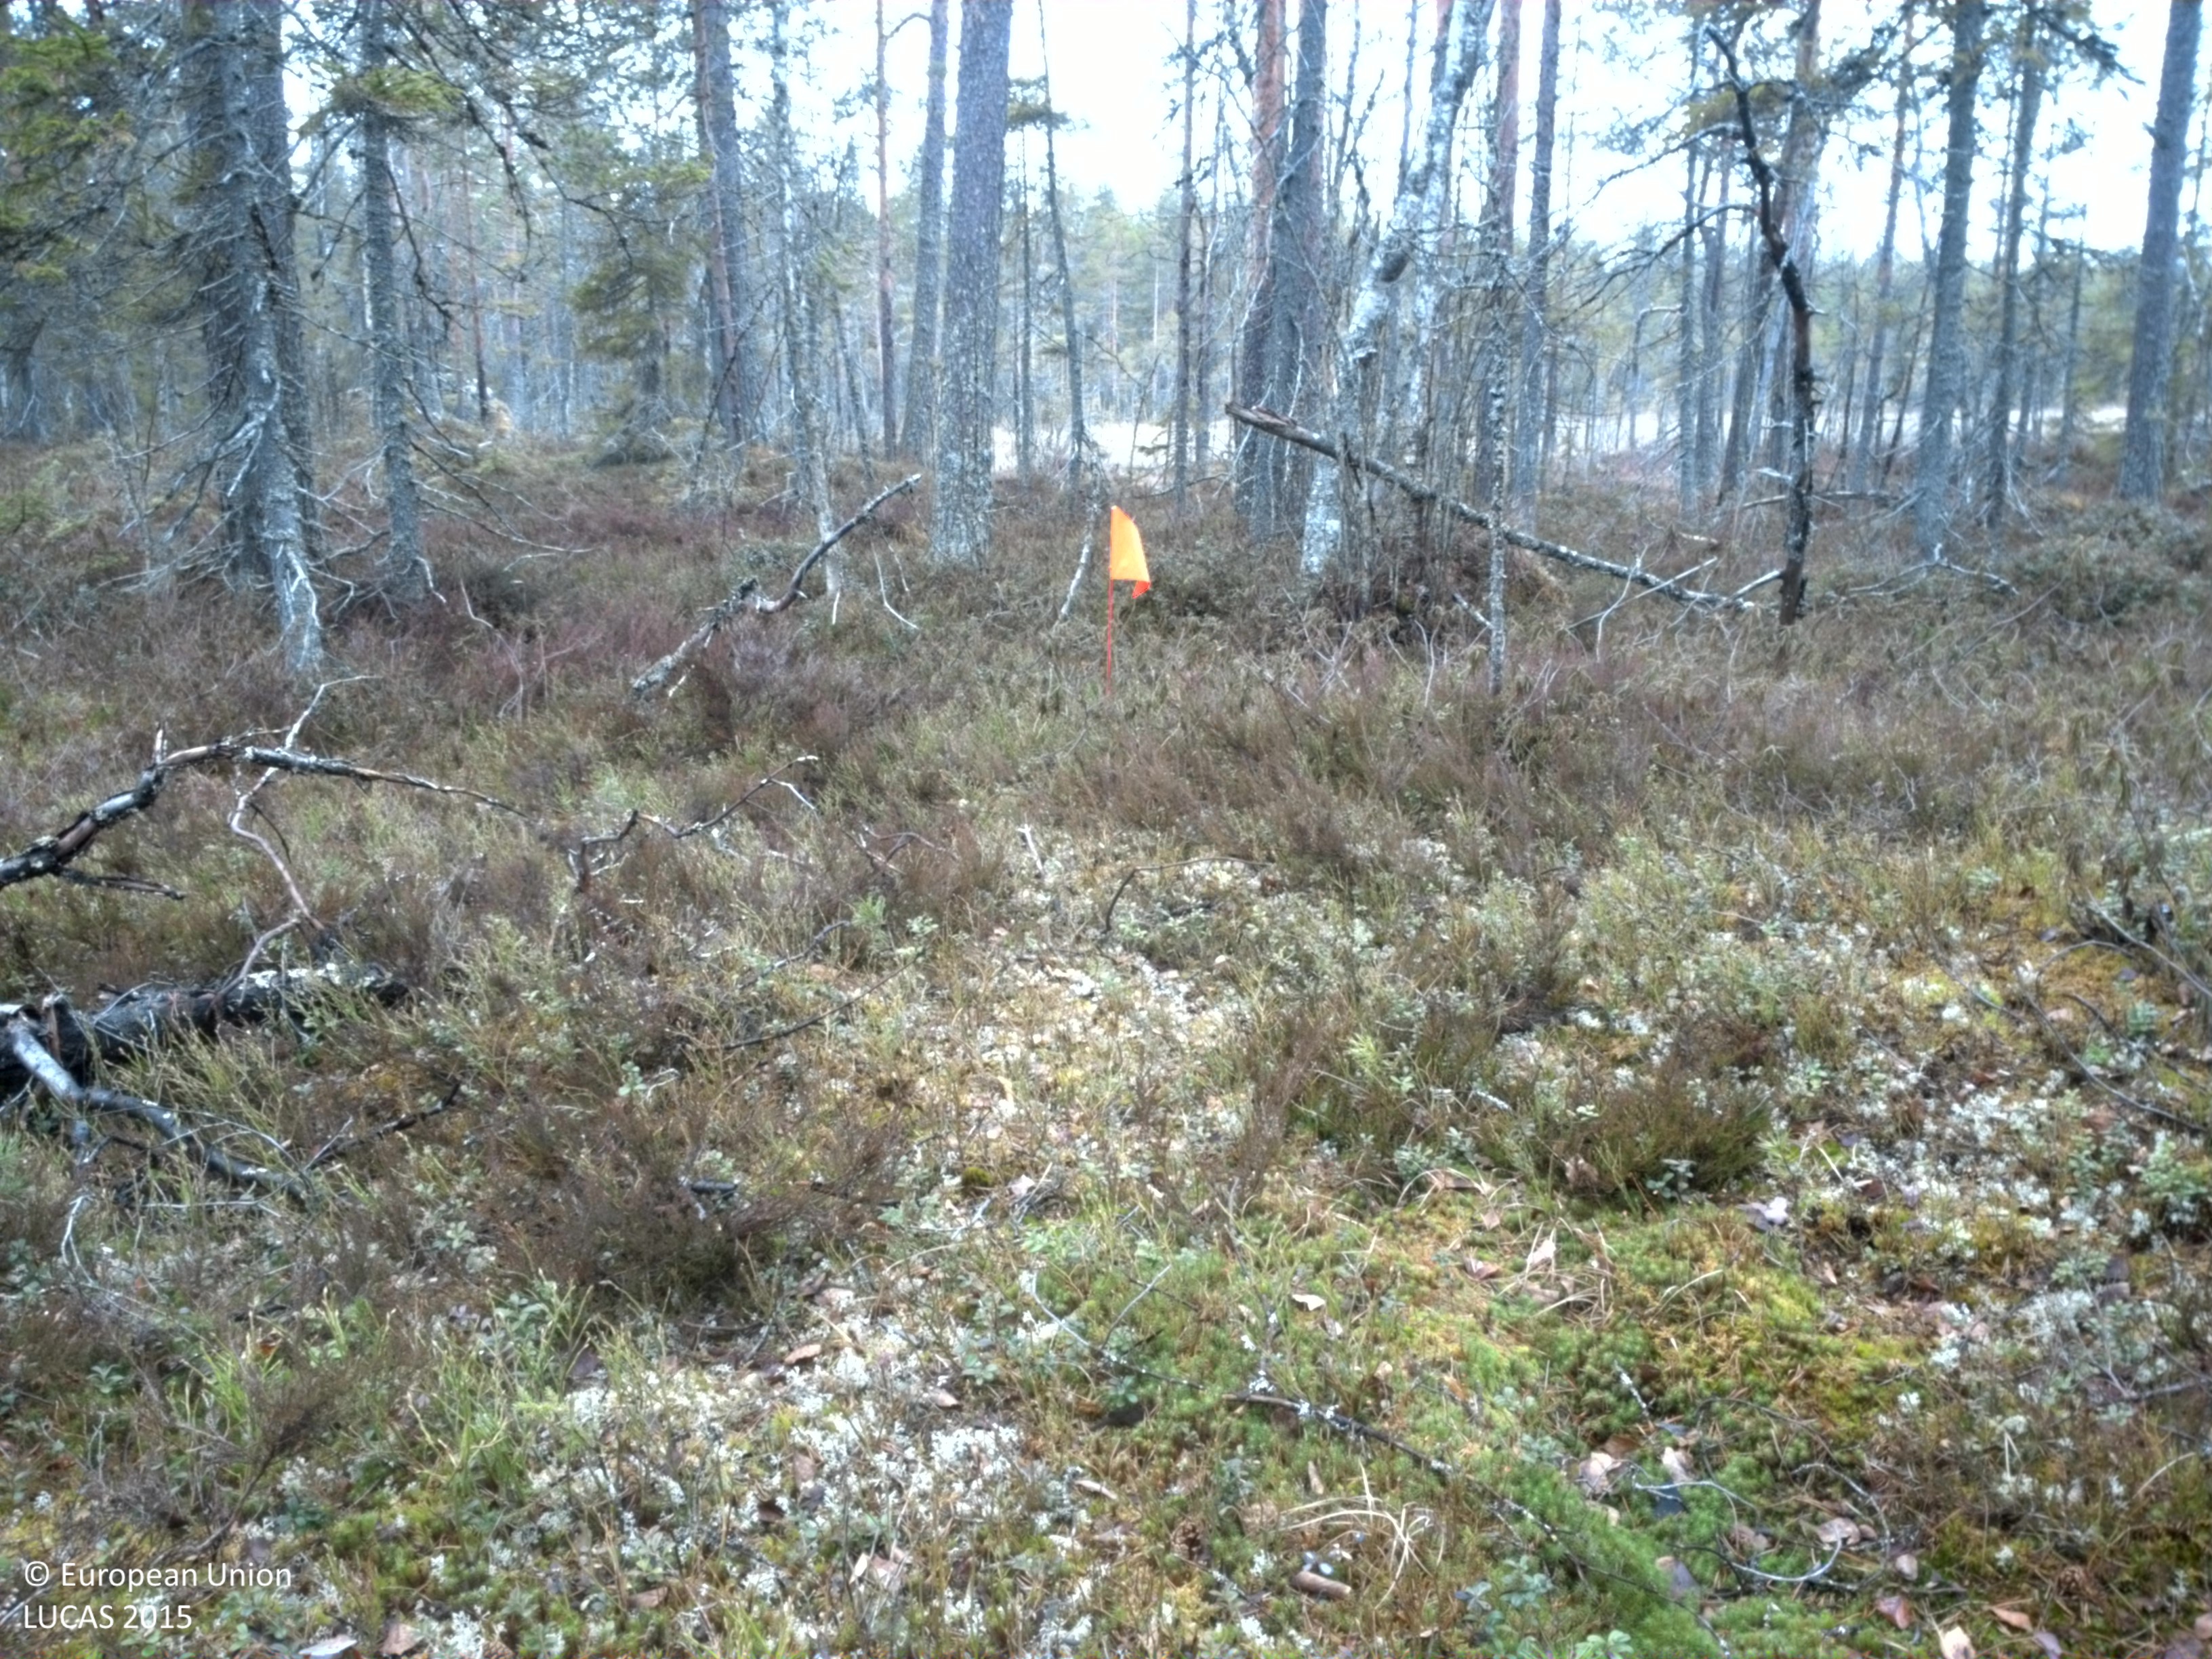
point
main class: Woodland
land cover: Other coniferous woodland
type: boreal forest
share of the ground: > 75 %
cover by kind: coniferous forest trees 75 %, shrubs 15 %, broadleaved forest trees 5 %, lichens and mosses 5 %
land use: Forestry
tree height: > 5 m
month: May
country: SE
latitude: 65.8680
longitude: 22.9399
